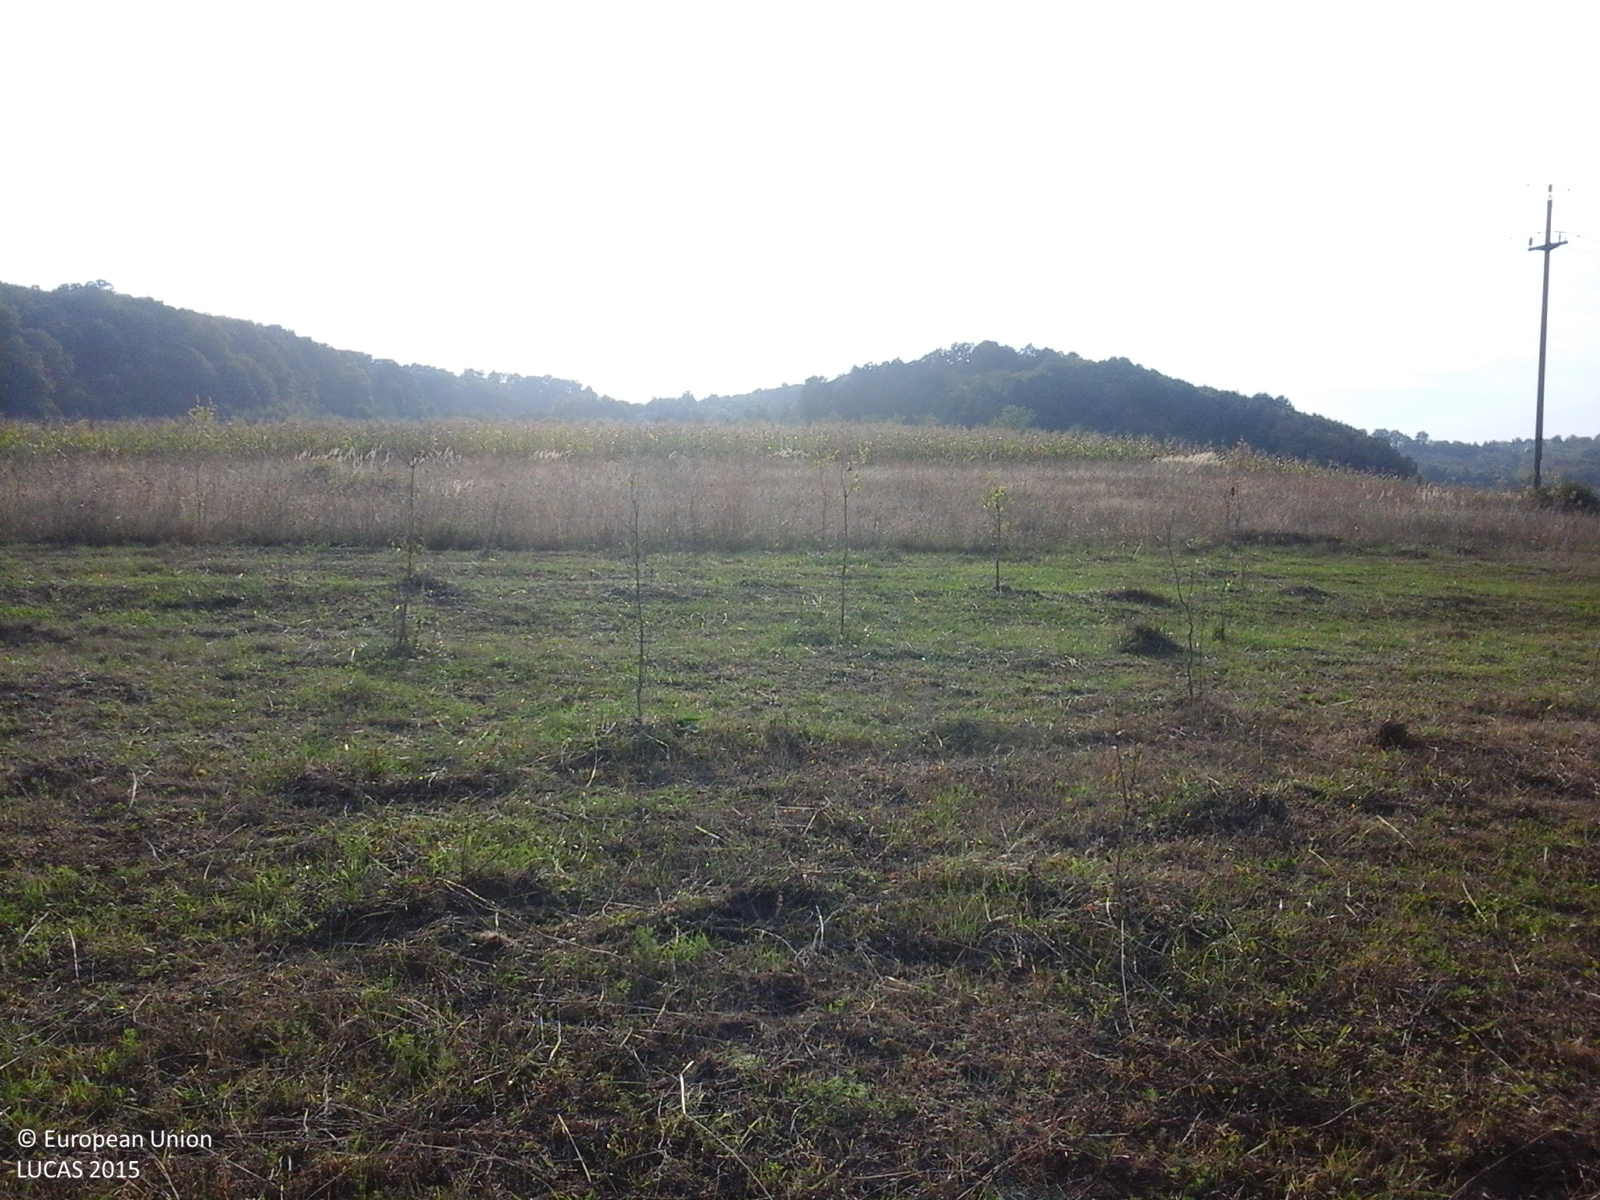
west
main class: Cropland
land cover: Other fruit trees and berries
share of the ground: > 75 %
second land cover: Grassland without tree/shrub cover
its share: > 75 %
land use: Agriculture (excluding fallow land and kitchen gardens)
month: September
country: RO
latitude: 47.2289
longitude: 23.3161
